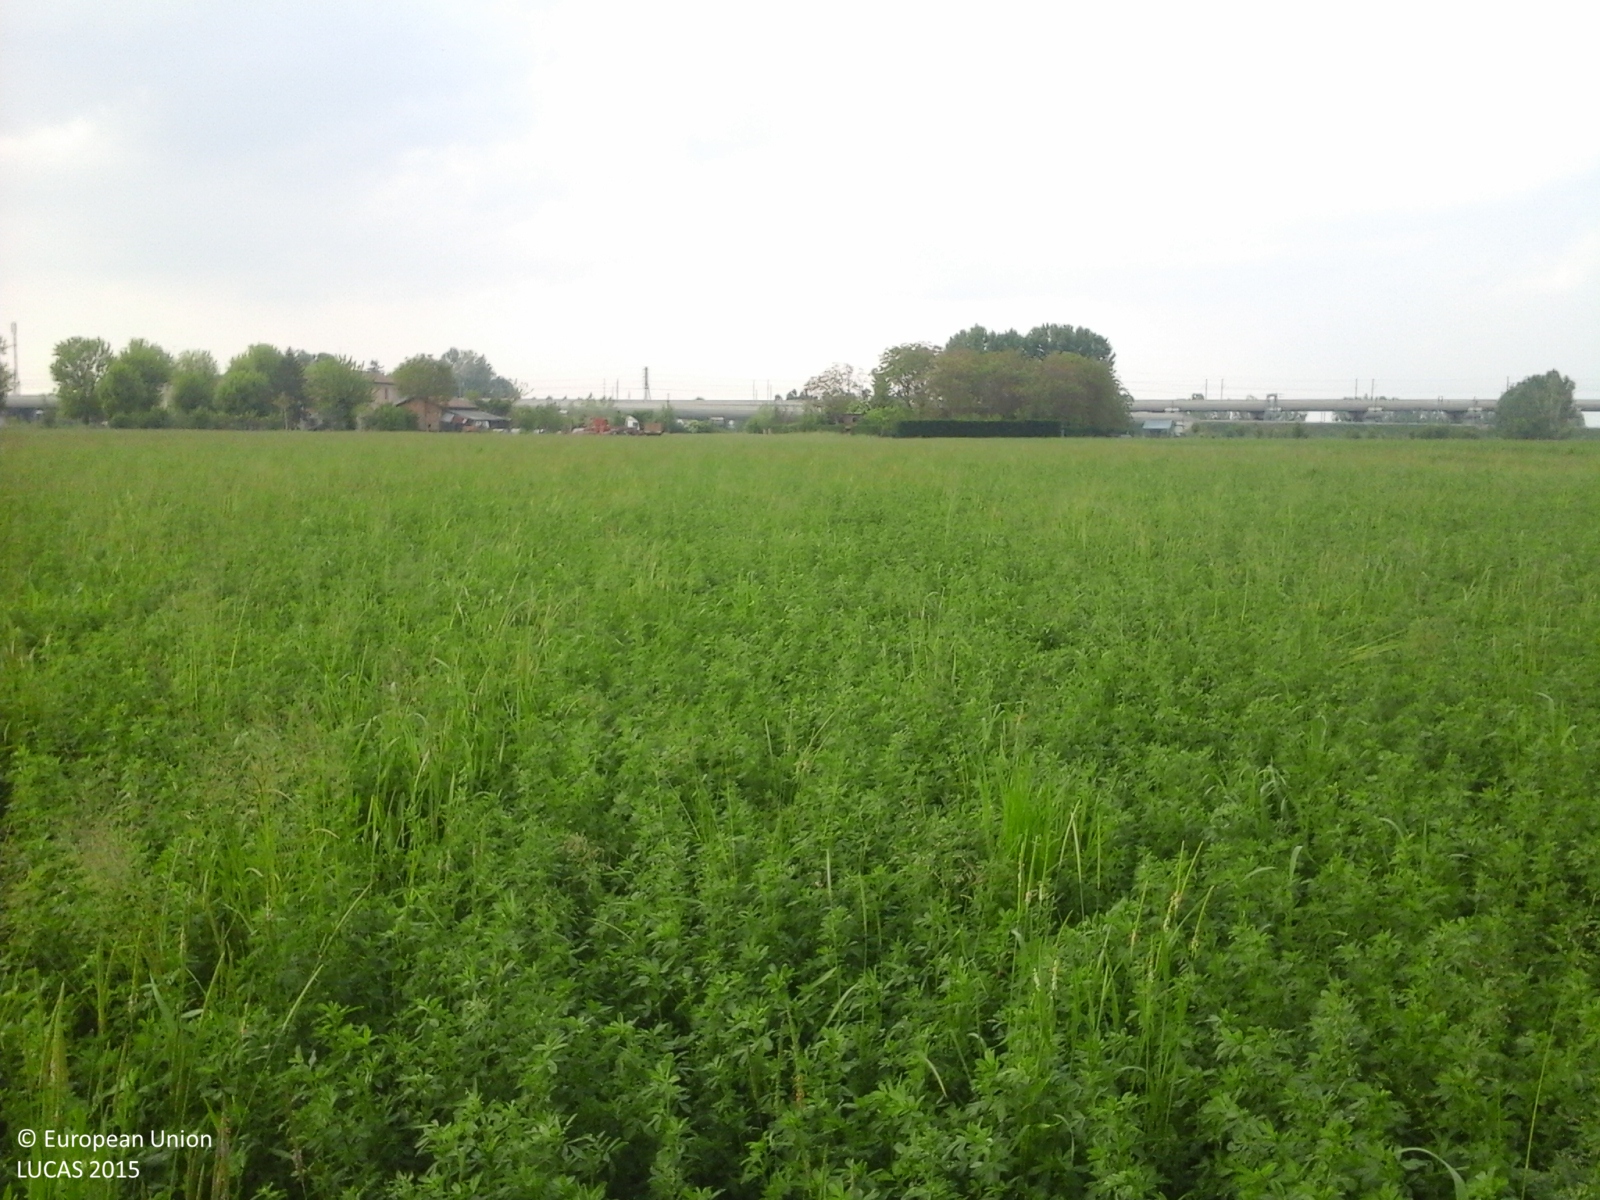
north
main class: Cropland
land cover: Lucerne
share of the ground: > 75 %
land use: Agriculture (excluding fallow land and kitchen gardens)
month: April
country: IT
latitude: 44.6894
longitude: 10.8940
